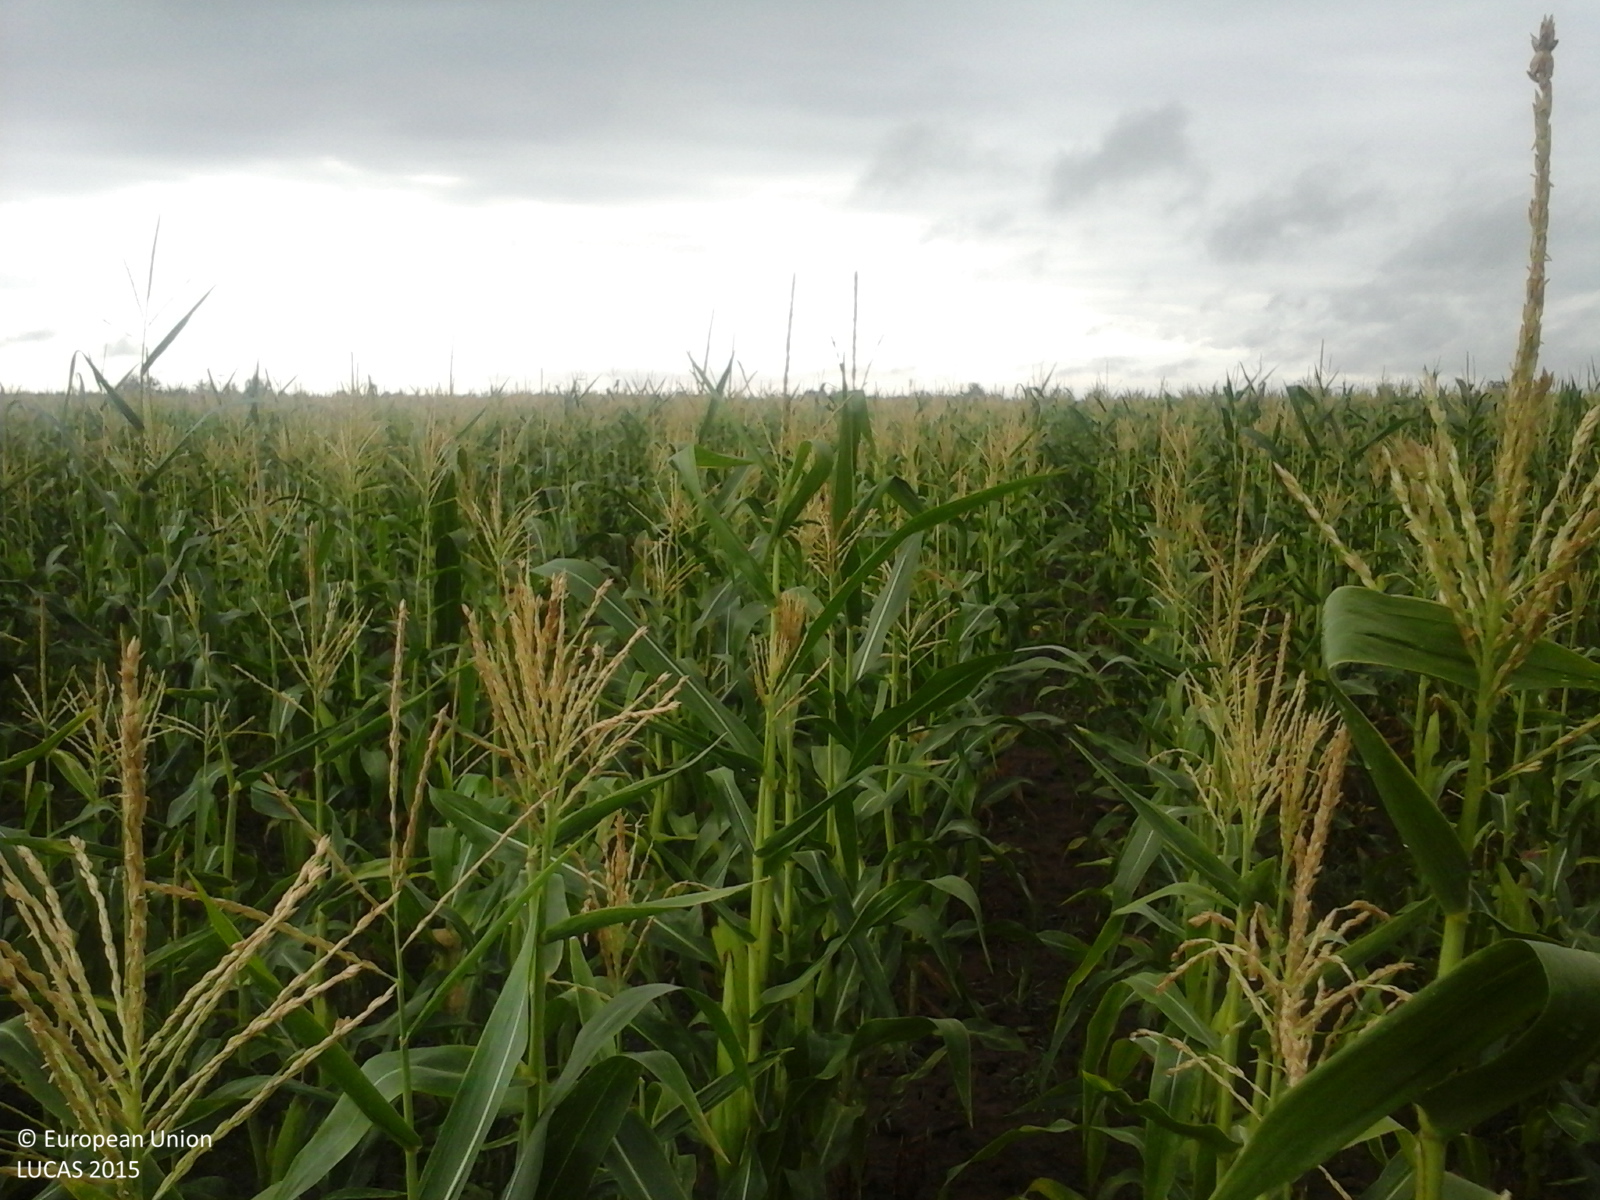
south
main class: Cropland
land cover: Maize
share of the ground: > 75 %
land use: Agriculture (excluding fallow land and kitchen gardens)
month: August
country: RO
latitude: 45.7708
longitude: 21.7779
